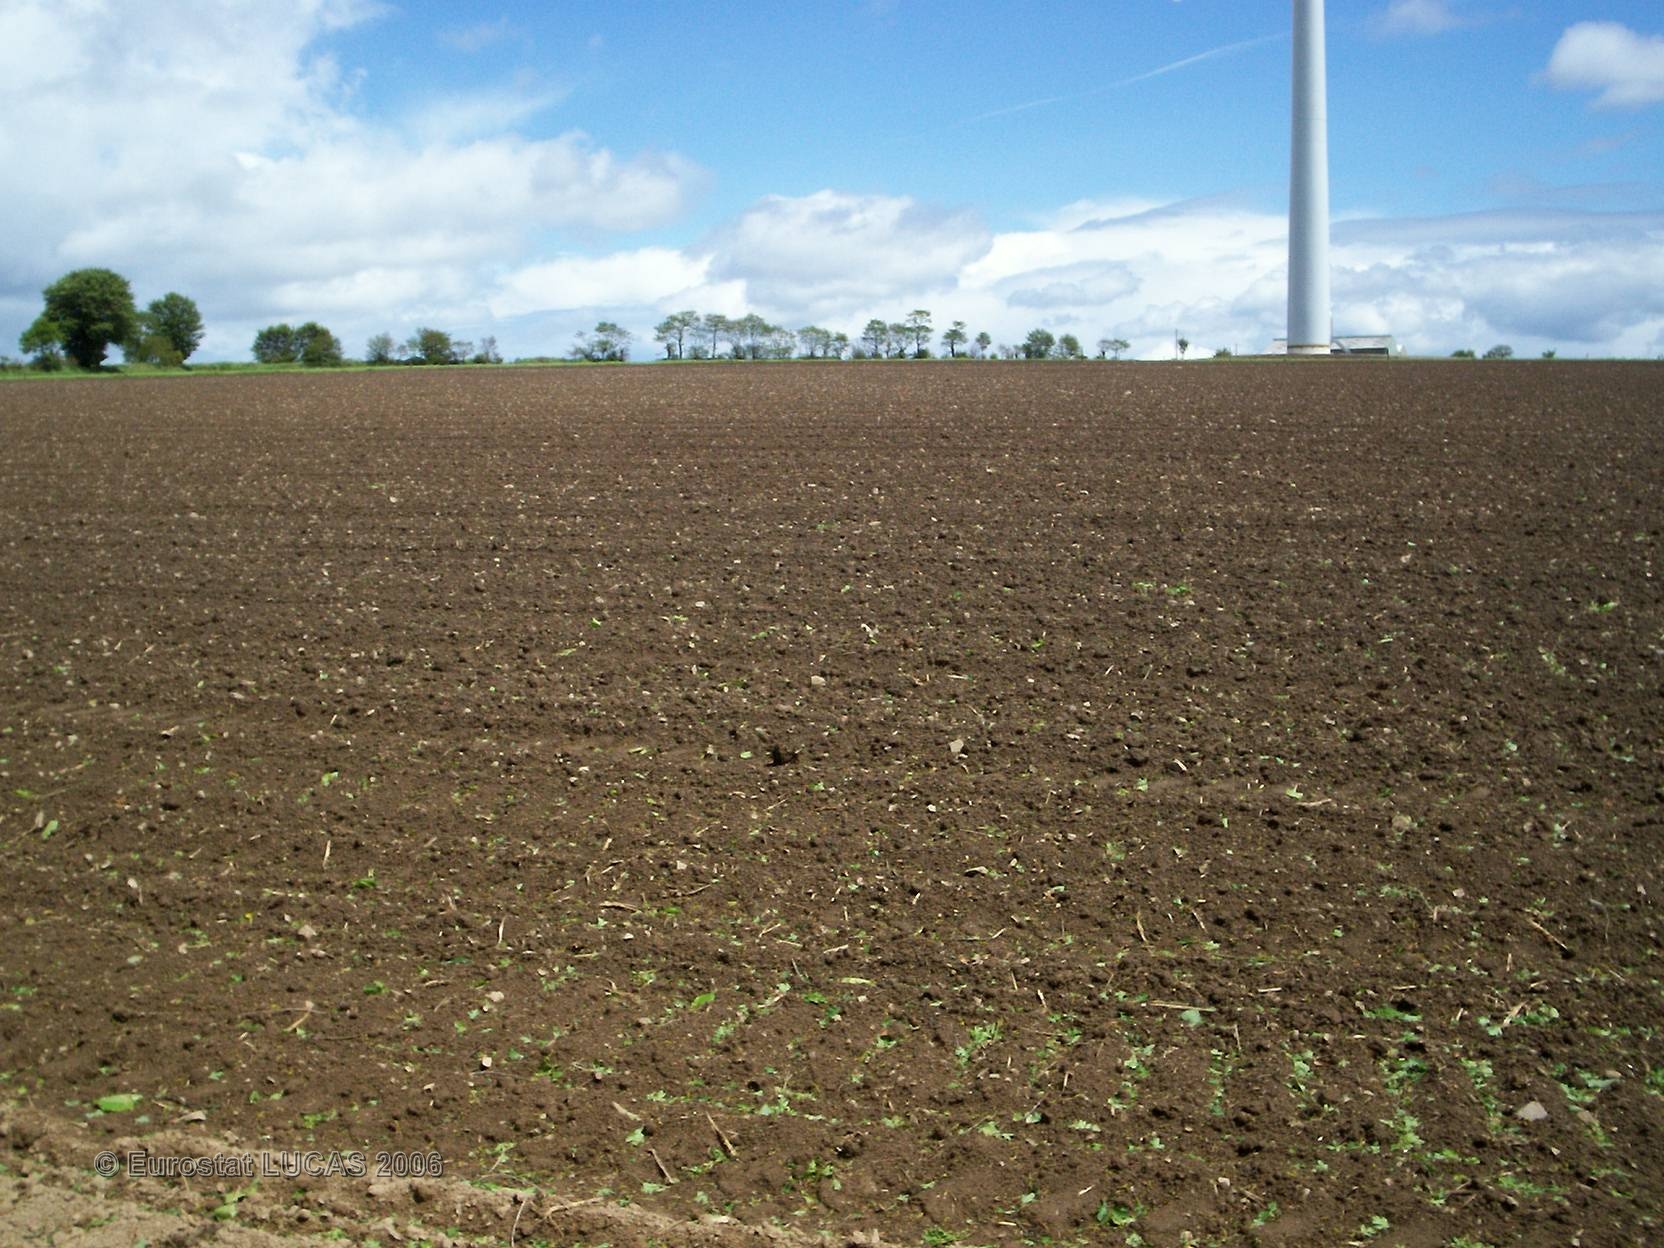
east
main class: Cropland
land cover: Maize
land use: Agriculture (excluding fallow land and kitchen gardens)
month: June
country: FR
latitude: 48.3512
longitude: -2.9282
